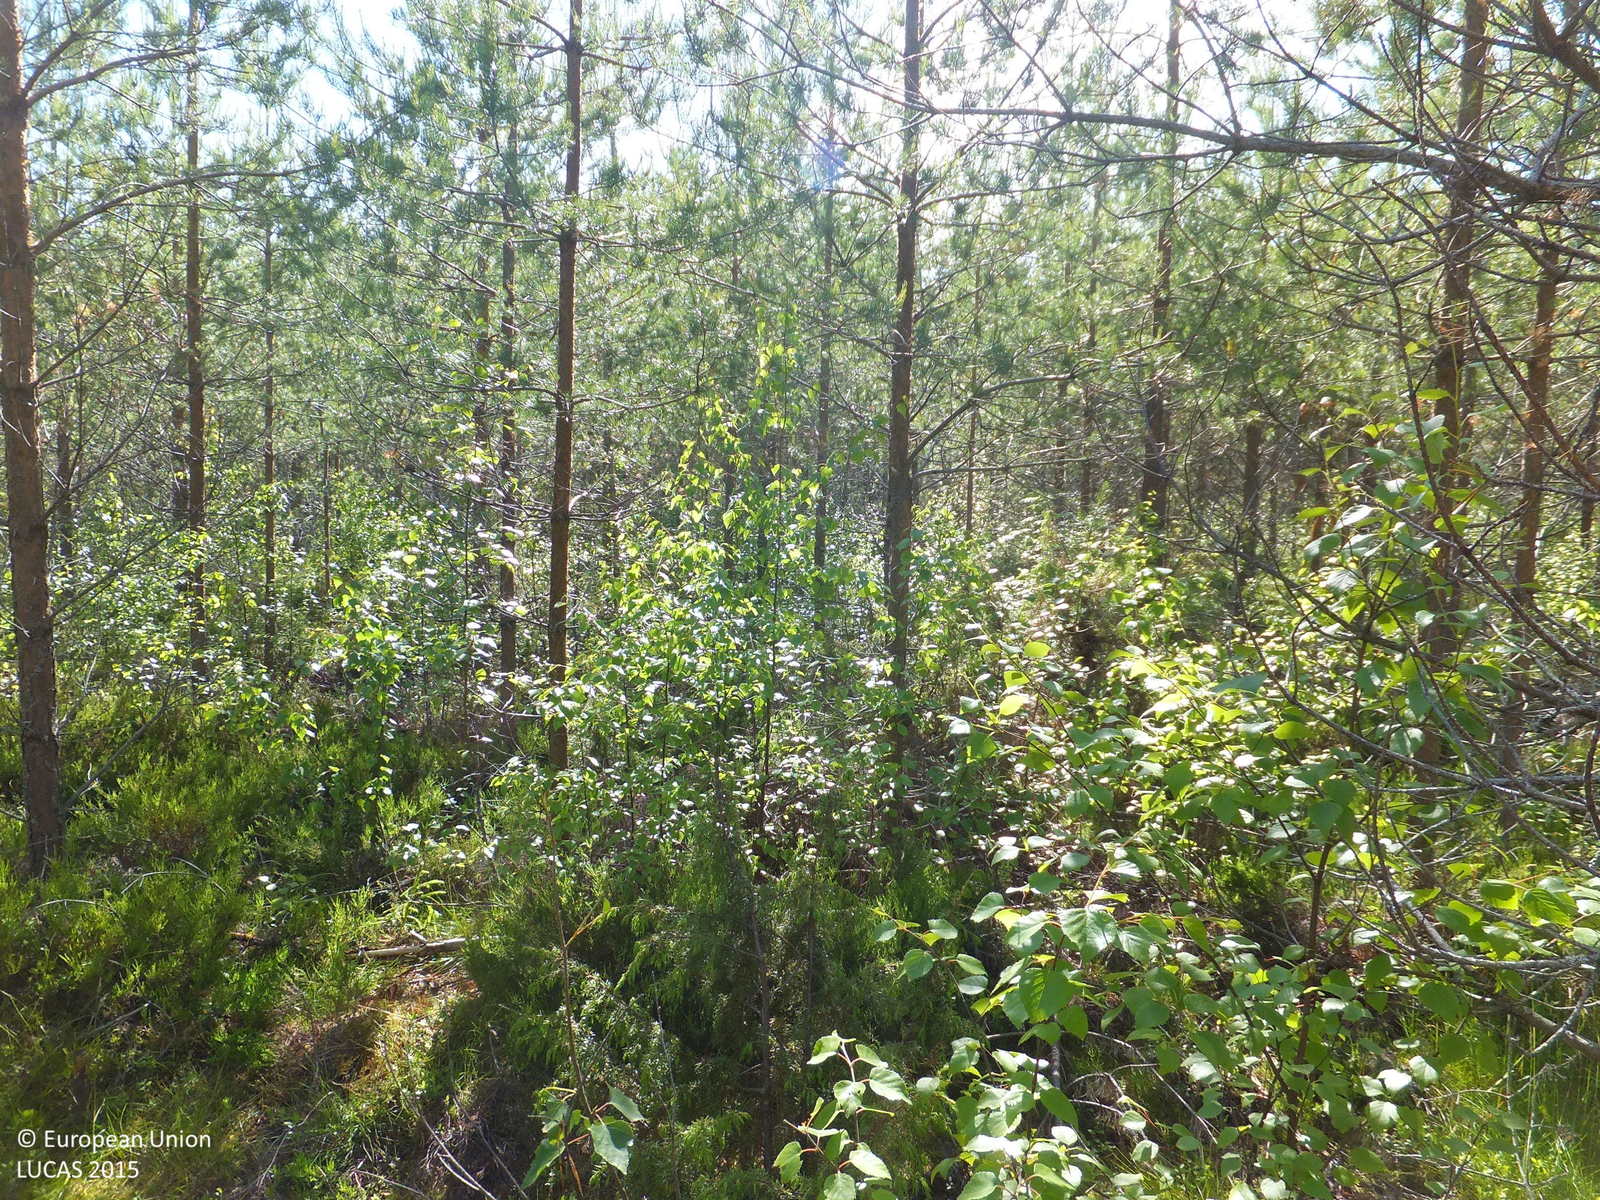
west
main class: Woodland
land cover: Pine dominated coniferous woodland
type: boreal forest
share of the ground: > 75 %
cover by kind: coniferous forest trees 80 %, shrubs 10 %, broadleaved forest trees 5 %, herbaceous plants 5 %
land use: Forestry
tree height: < 5 m
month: July
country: FI
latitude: 63.0862
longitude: 23.8743
